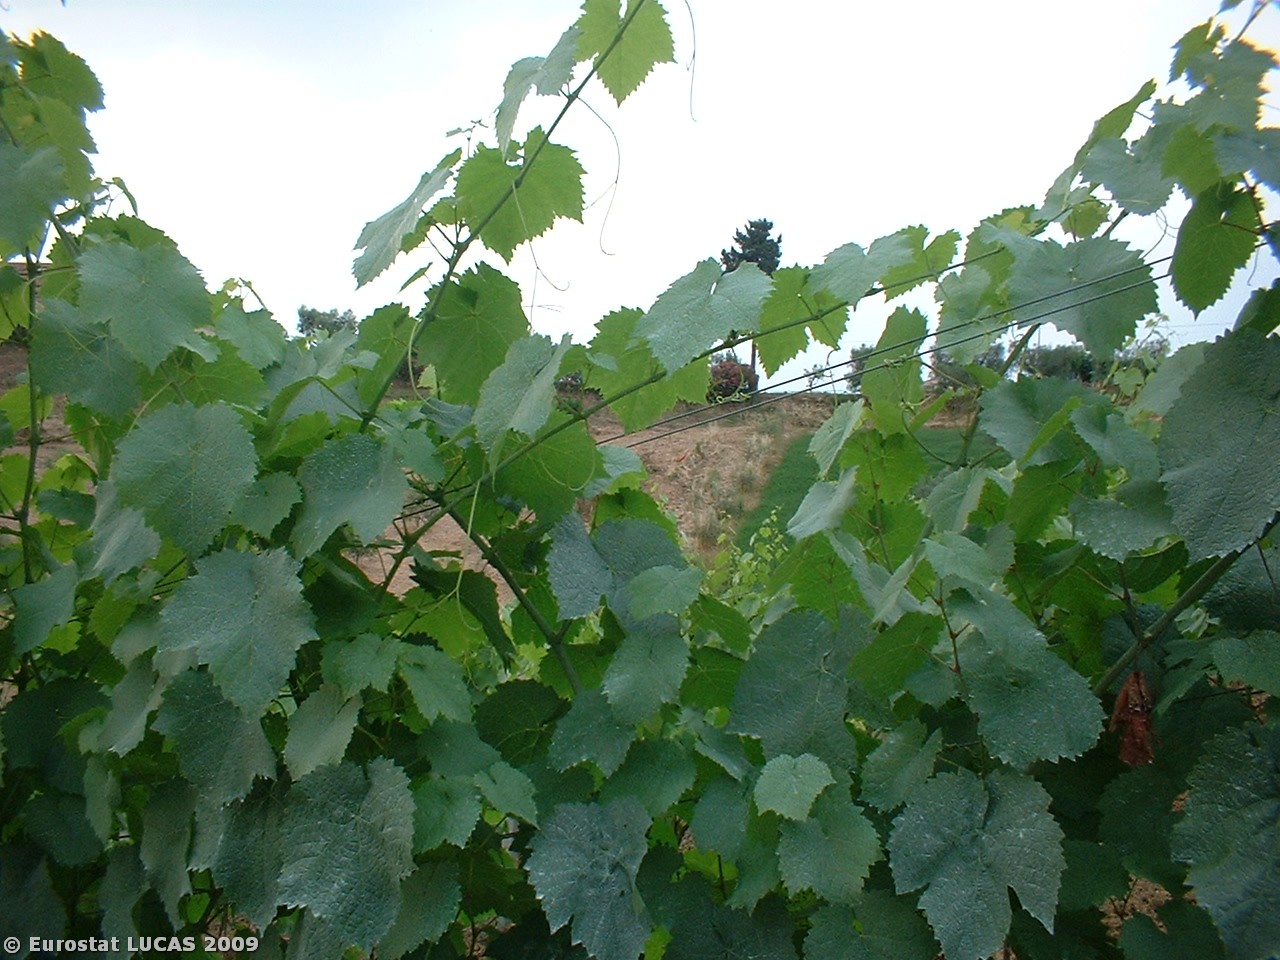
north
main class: Cropland
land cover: Vineyards
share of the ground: 25 - 50 %
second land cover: Bare land
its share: > 75 %
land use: Agriculture (excluding fallow land and kitchen gardens)
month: June
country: IT
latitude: 42.8928
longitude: 13.7246
